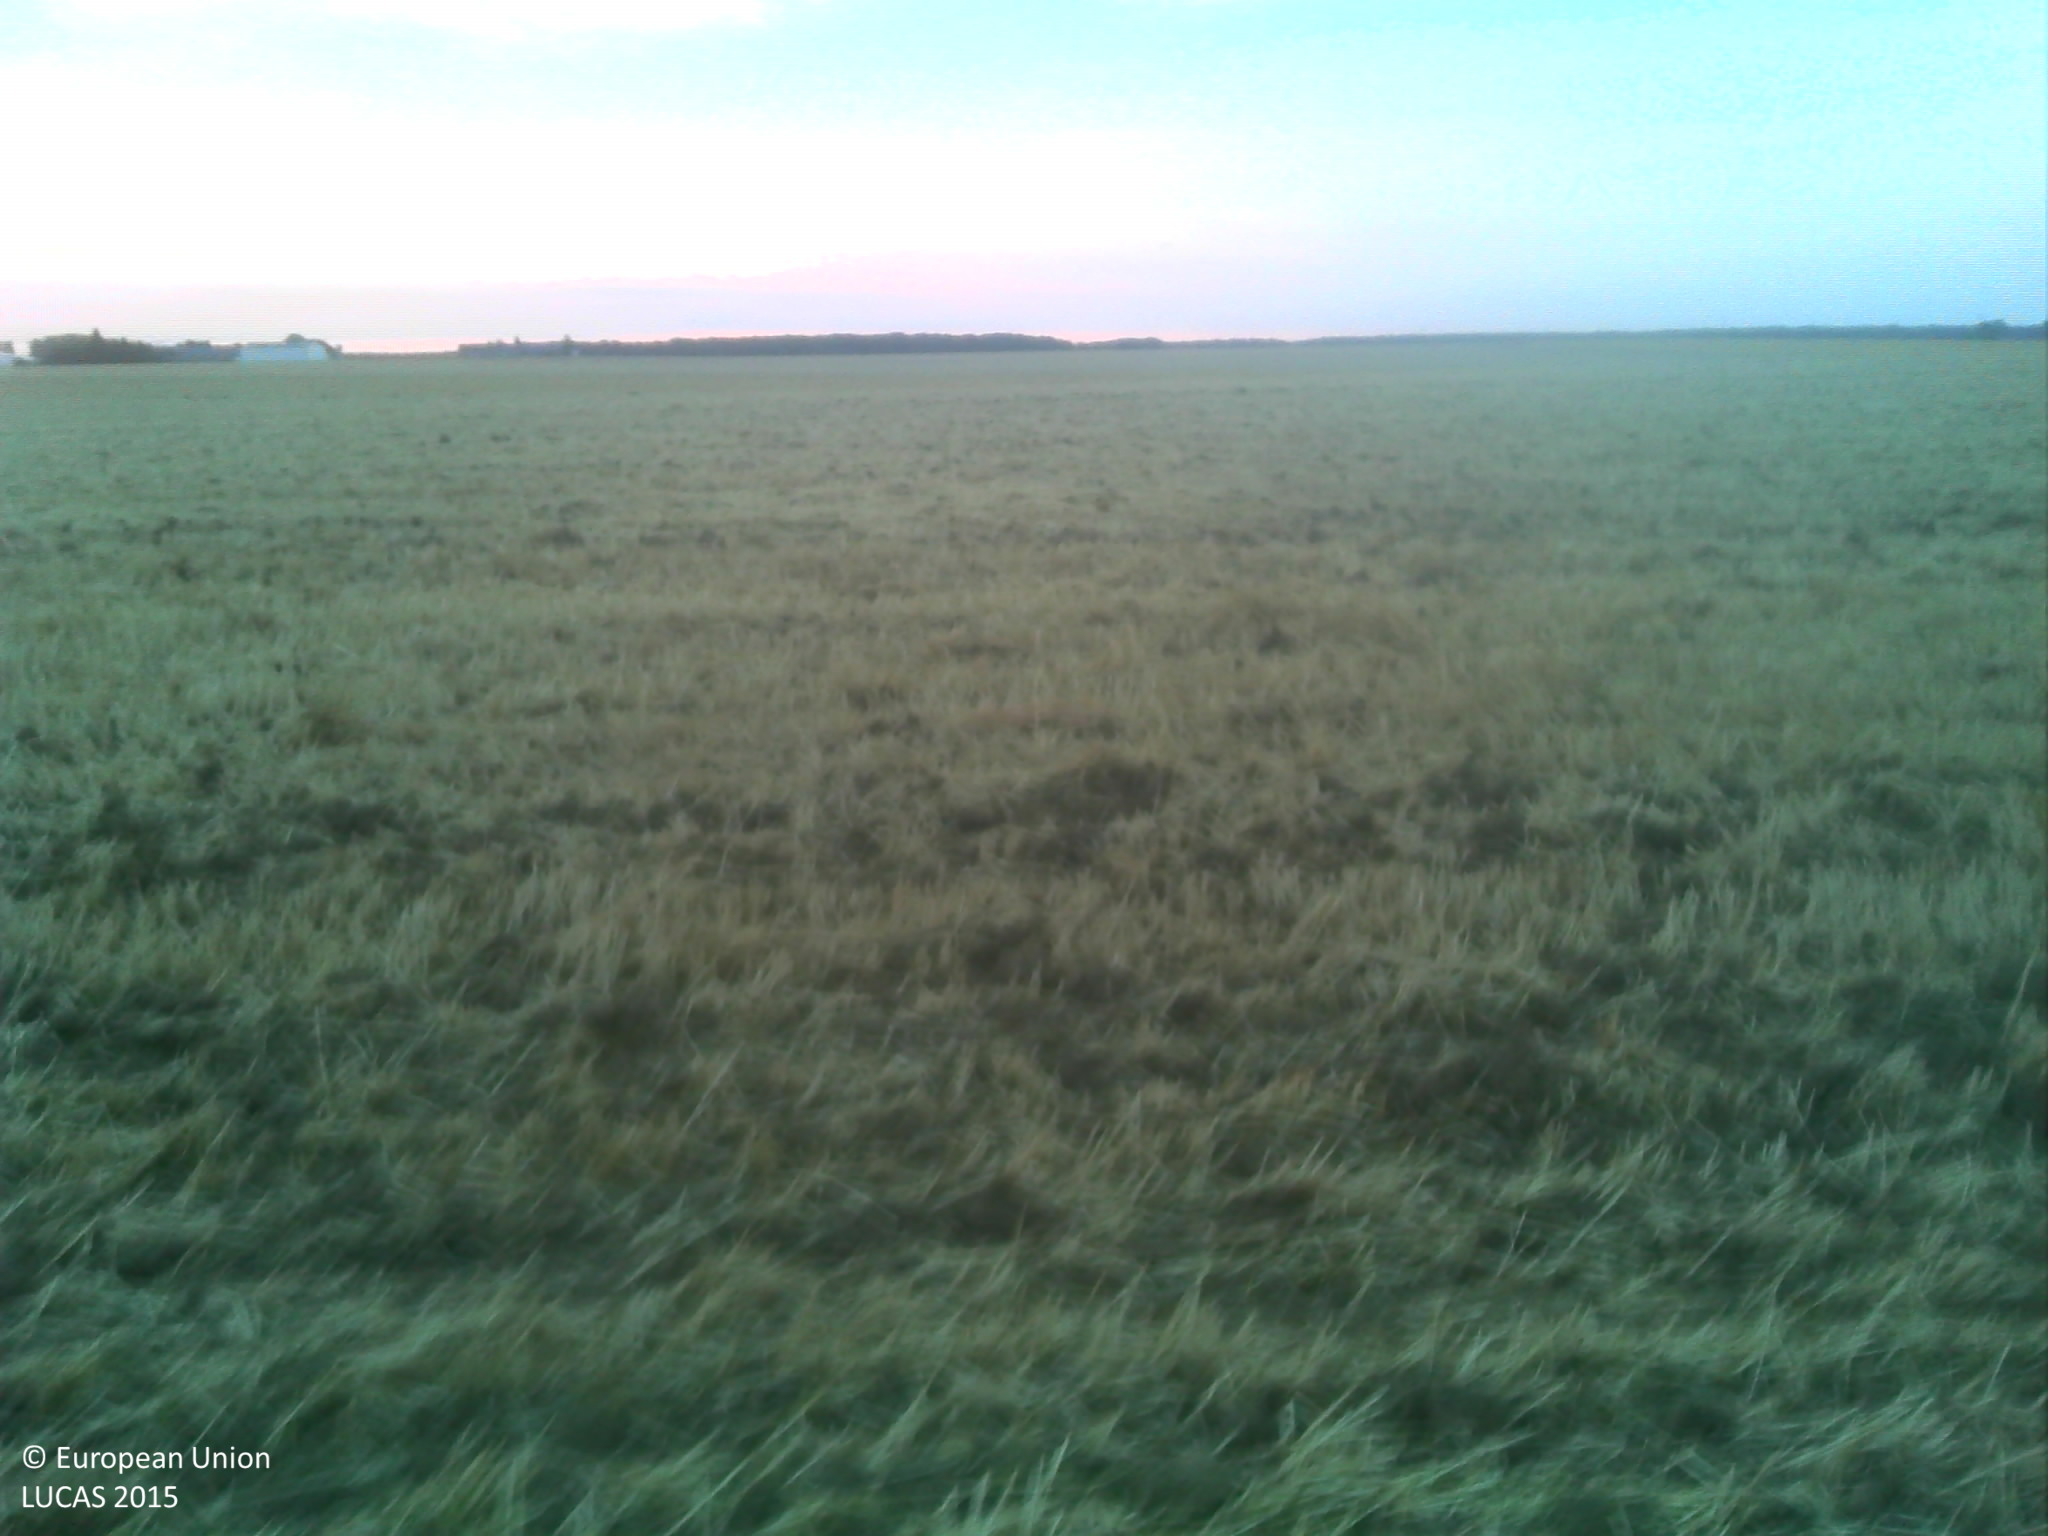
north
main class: Cropland
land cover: Sugar beet
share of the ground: > 75 %
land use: Agriculture (excluding fallow land and kitchen gardens)
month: July
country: FR
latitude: 47.8281
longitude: 1.3411
